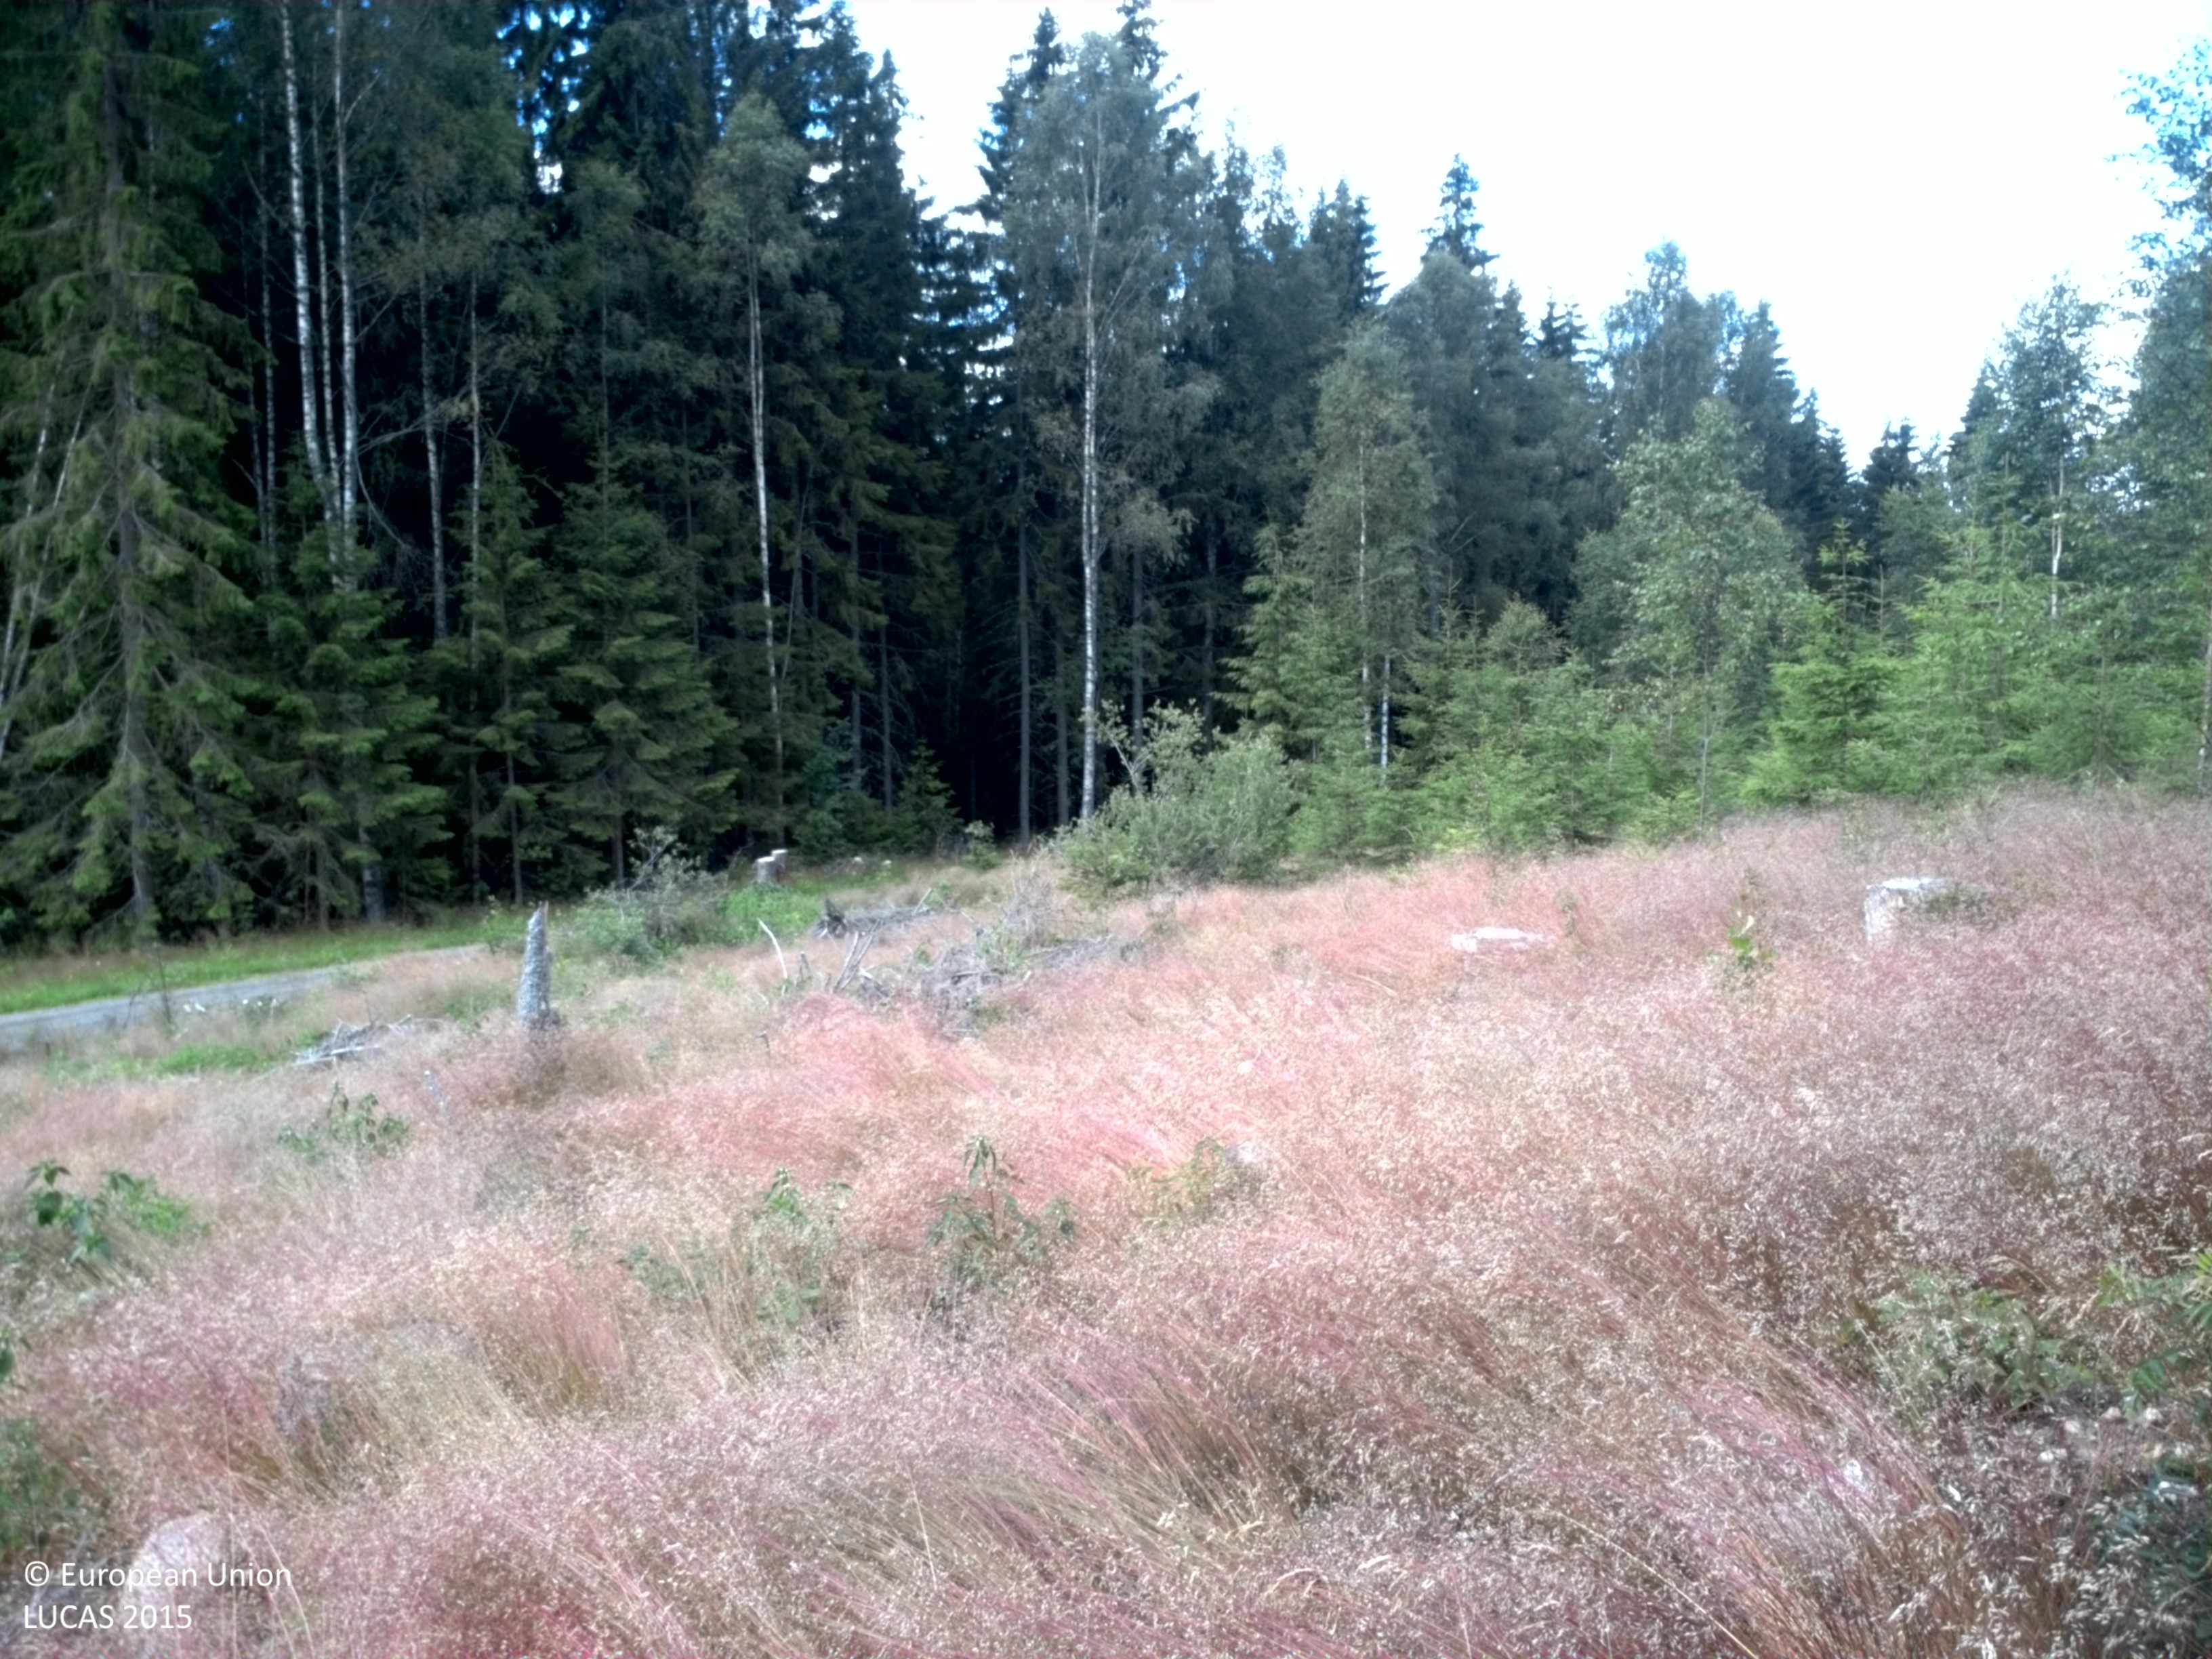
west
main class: Shrubland
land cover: Shrubland with sparse tree cover
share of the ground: 25 - 50 %
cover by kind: herbaceous plants 40 %, shrubs 35 %, consolidated bare surface 10 %, coniferous forest trees 5 %
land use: Forestry
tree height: < 5 m
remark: Clear cut
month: July
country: SE
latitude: 60.0010
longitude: 13.1652
